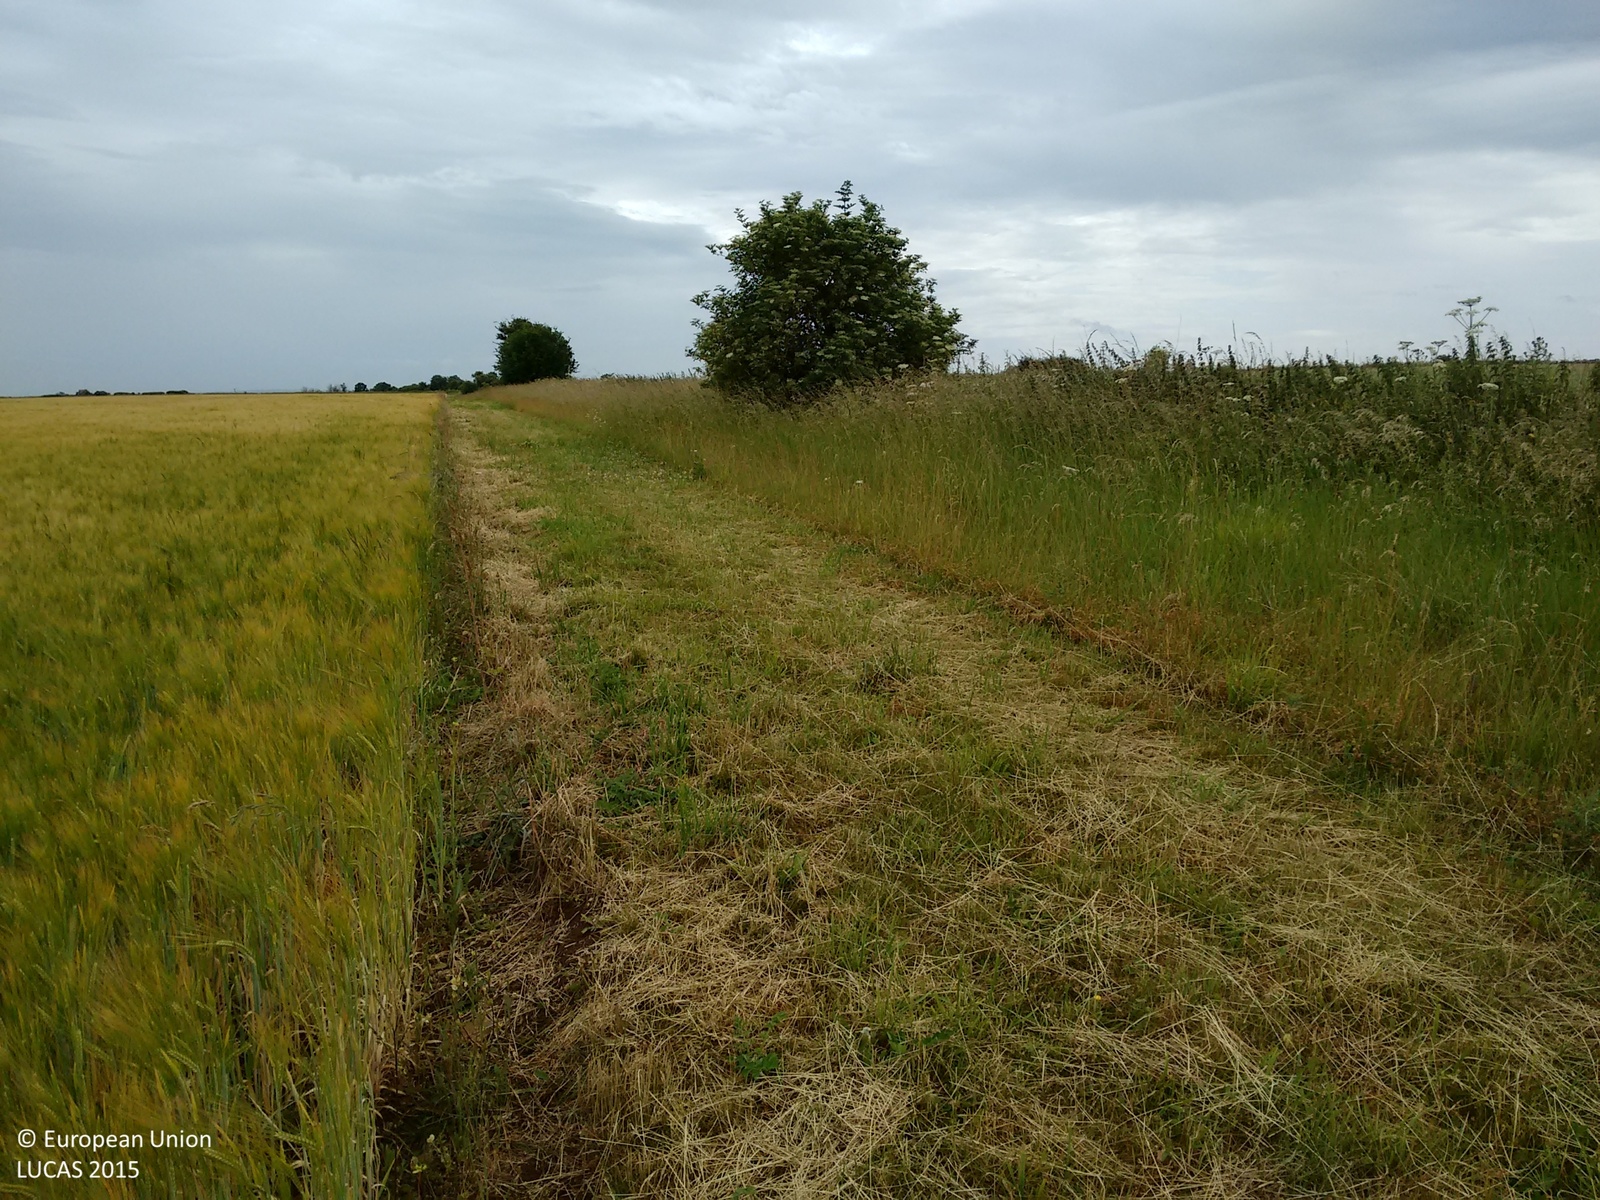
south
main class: Cropland
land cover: Barley
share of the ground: > 75 %
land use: Agriculture (excluding fallow land and kitchen gardens)
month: July
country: GB
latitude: 51.7848
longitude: -1.6356
